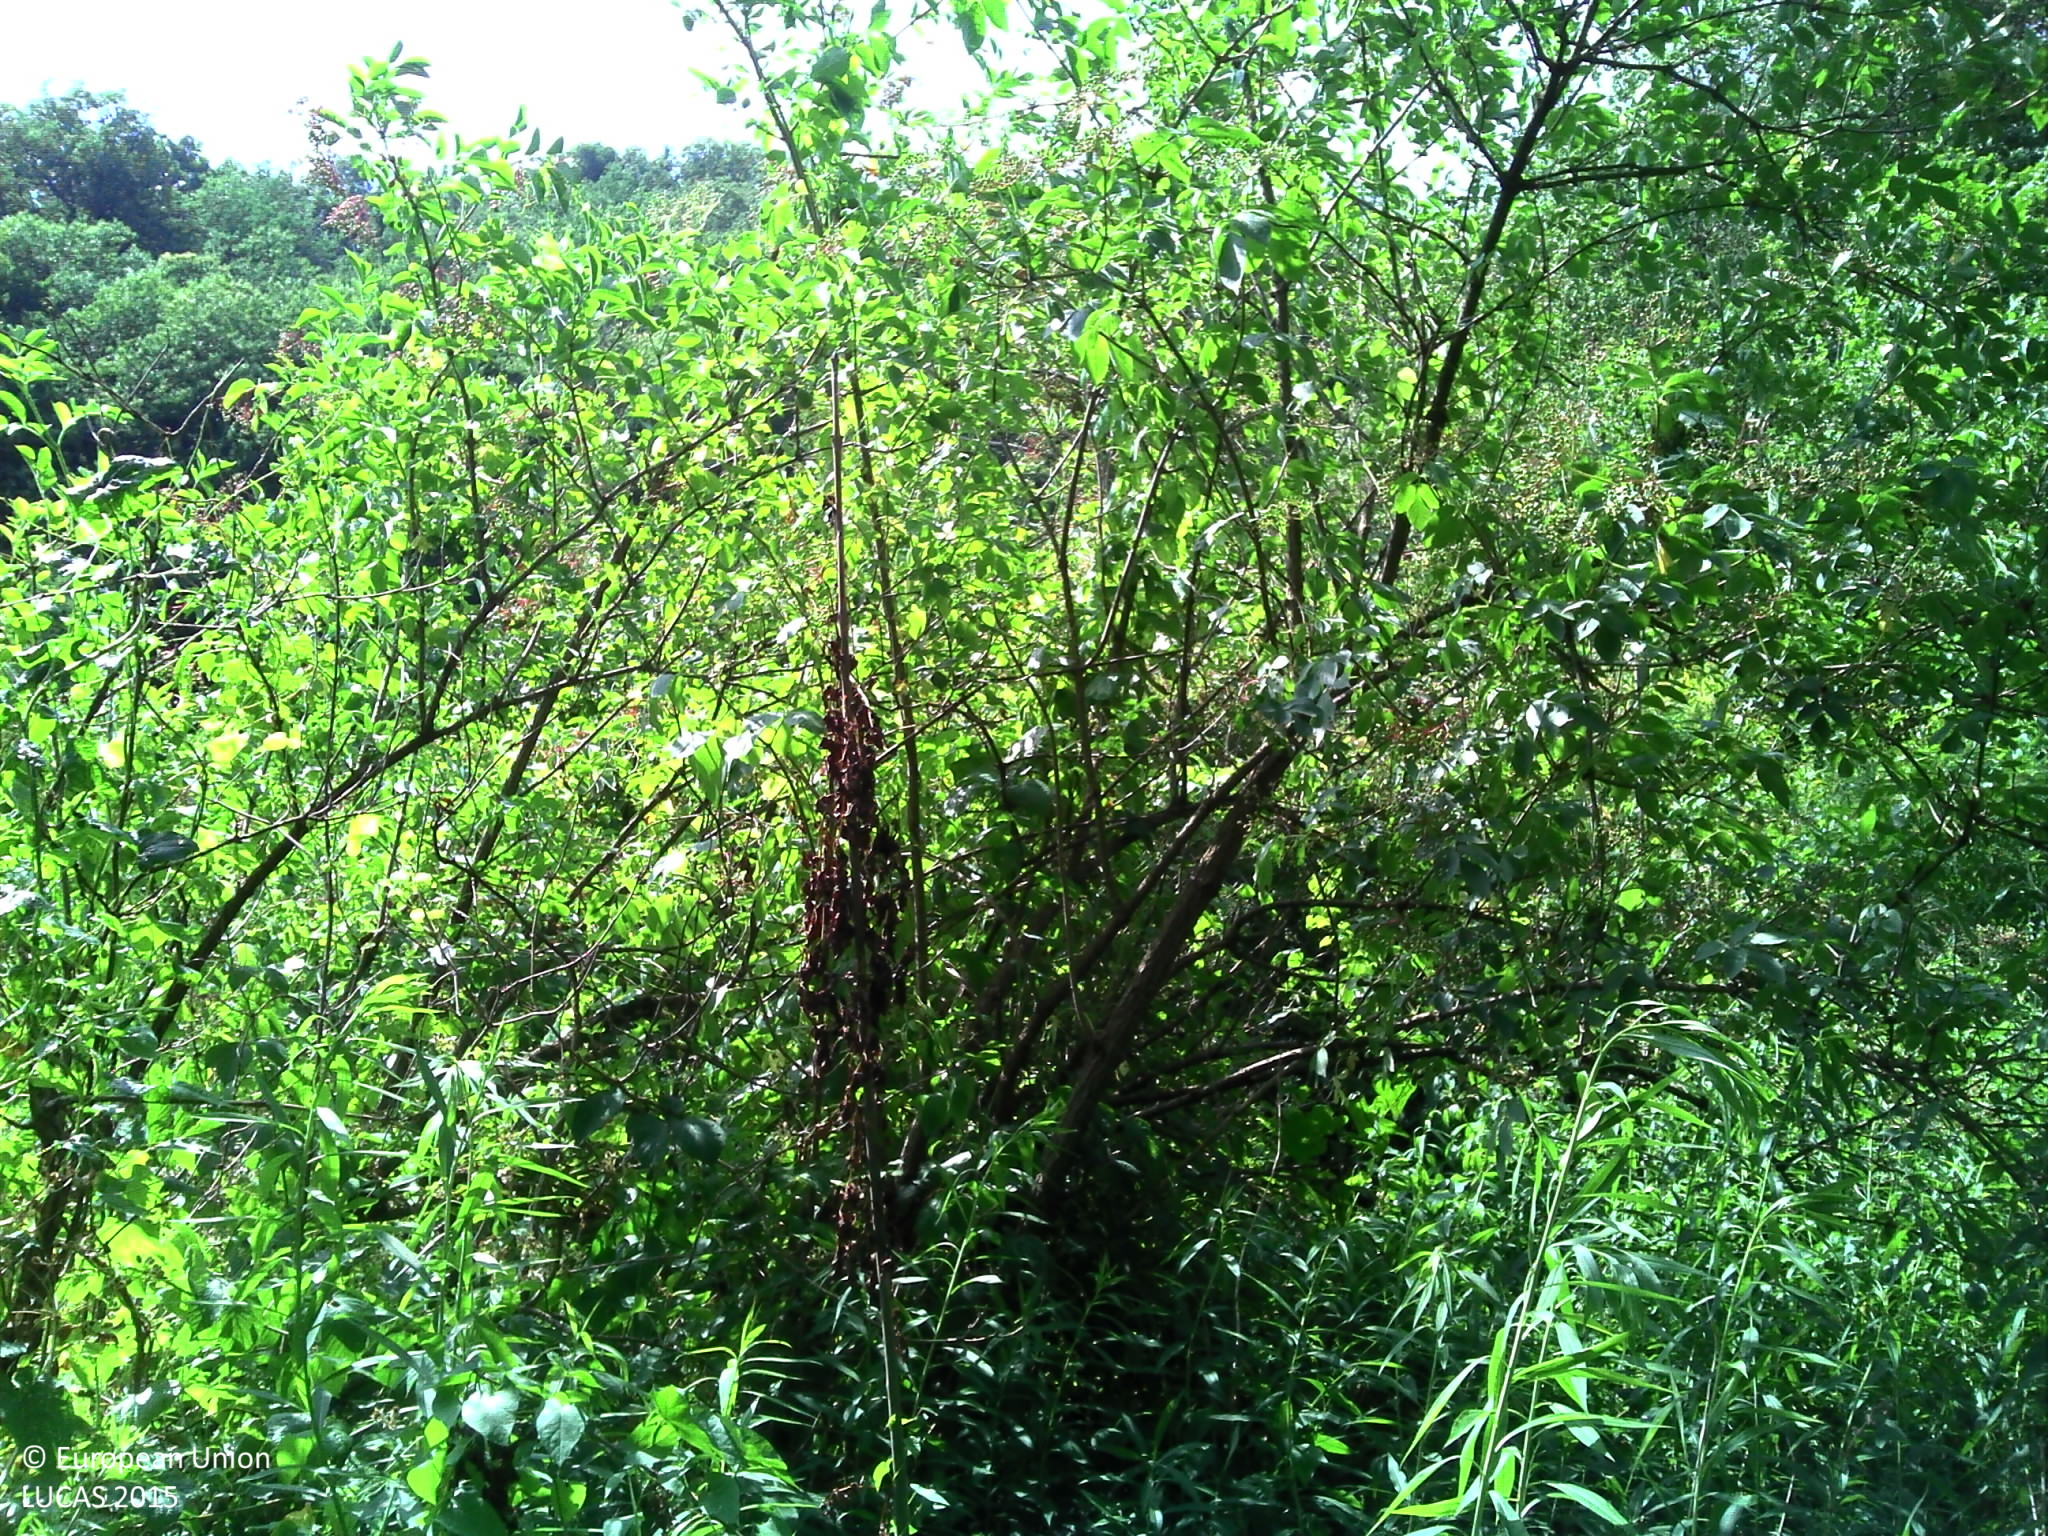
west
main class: Grassland
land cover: Grassland with sparse tree/shrub cover
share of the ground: > 75 %
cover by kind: herbaceous plants 85 %, shrubs 10 %, broadleaved forest trees 5 %
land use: Semi-natural and natural areas not in use
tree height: > 5 m
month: July
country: FR
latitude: 45.5925
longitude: 5.1716
